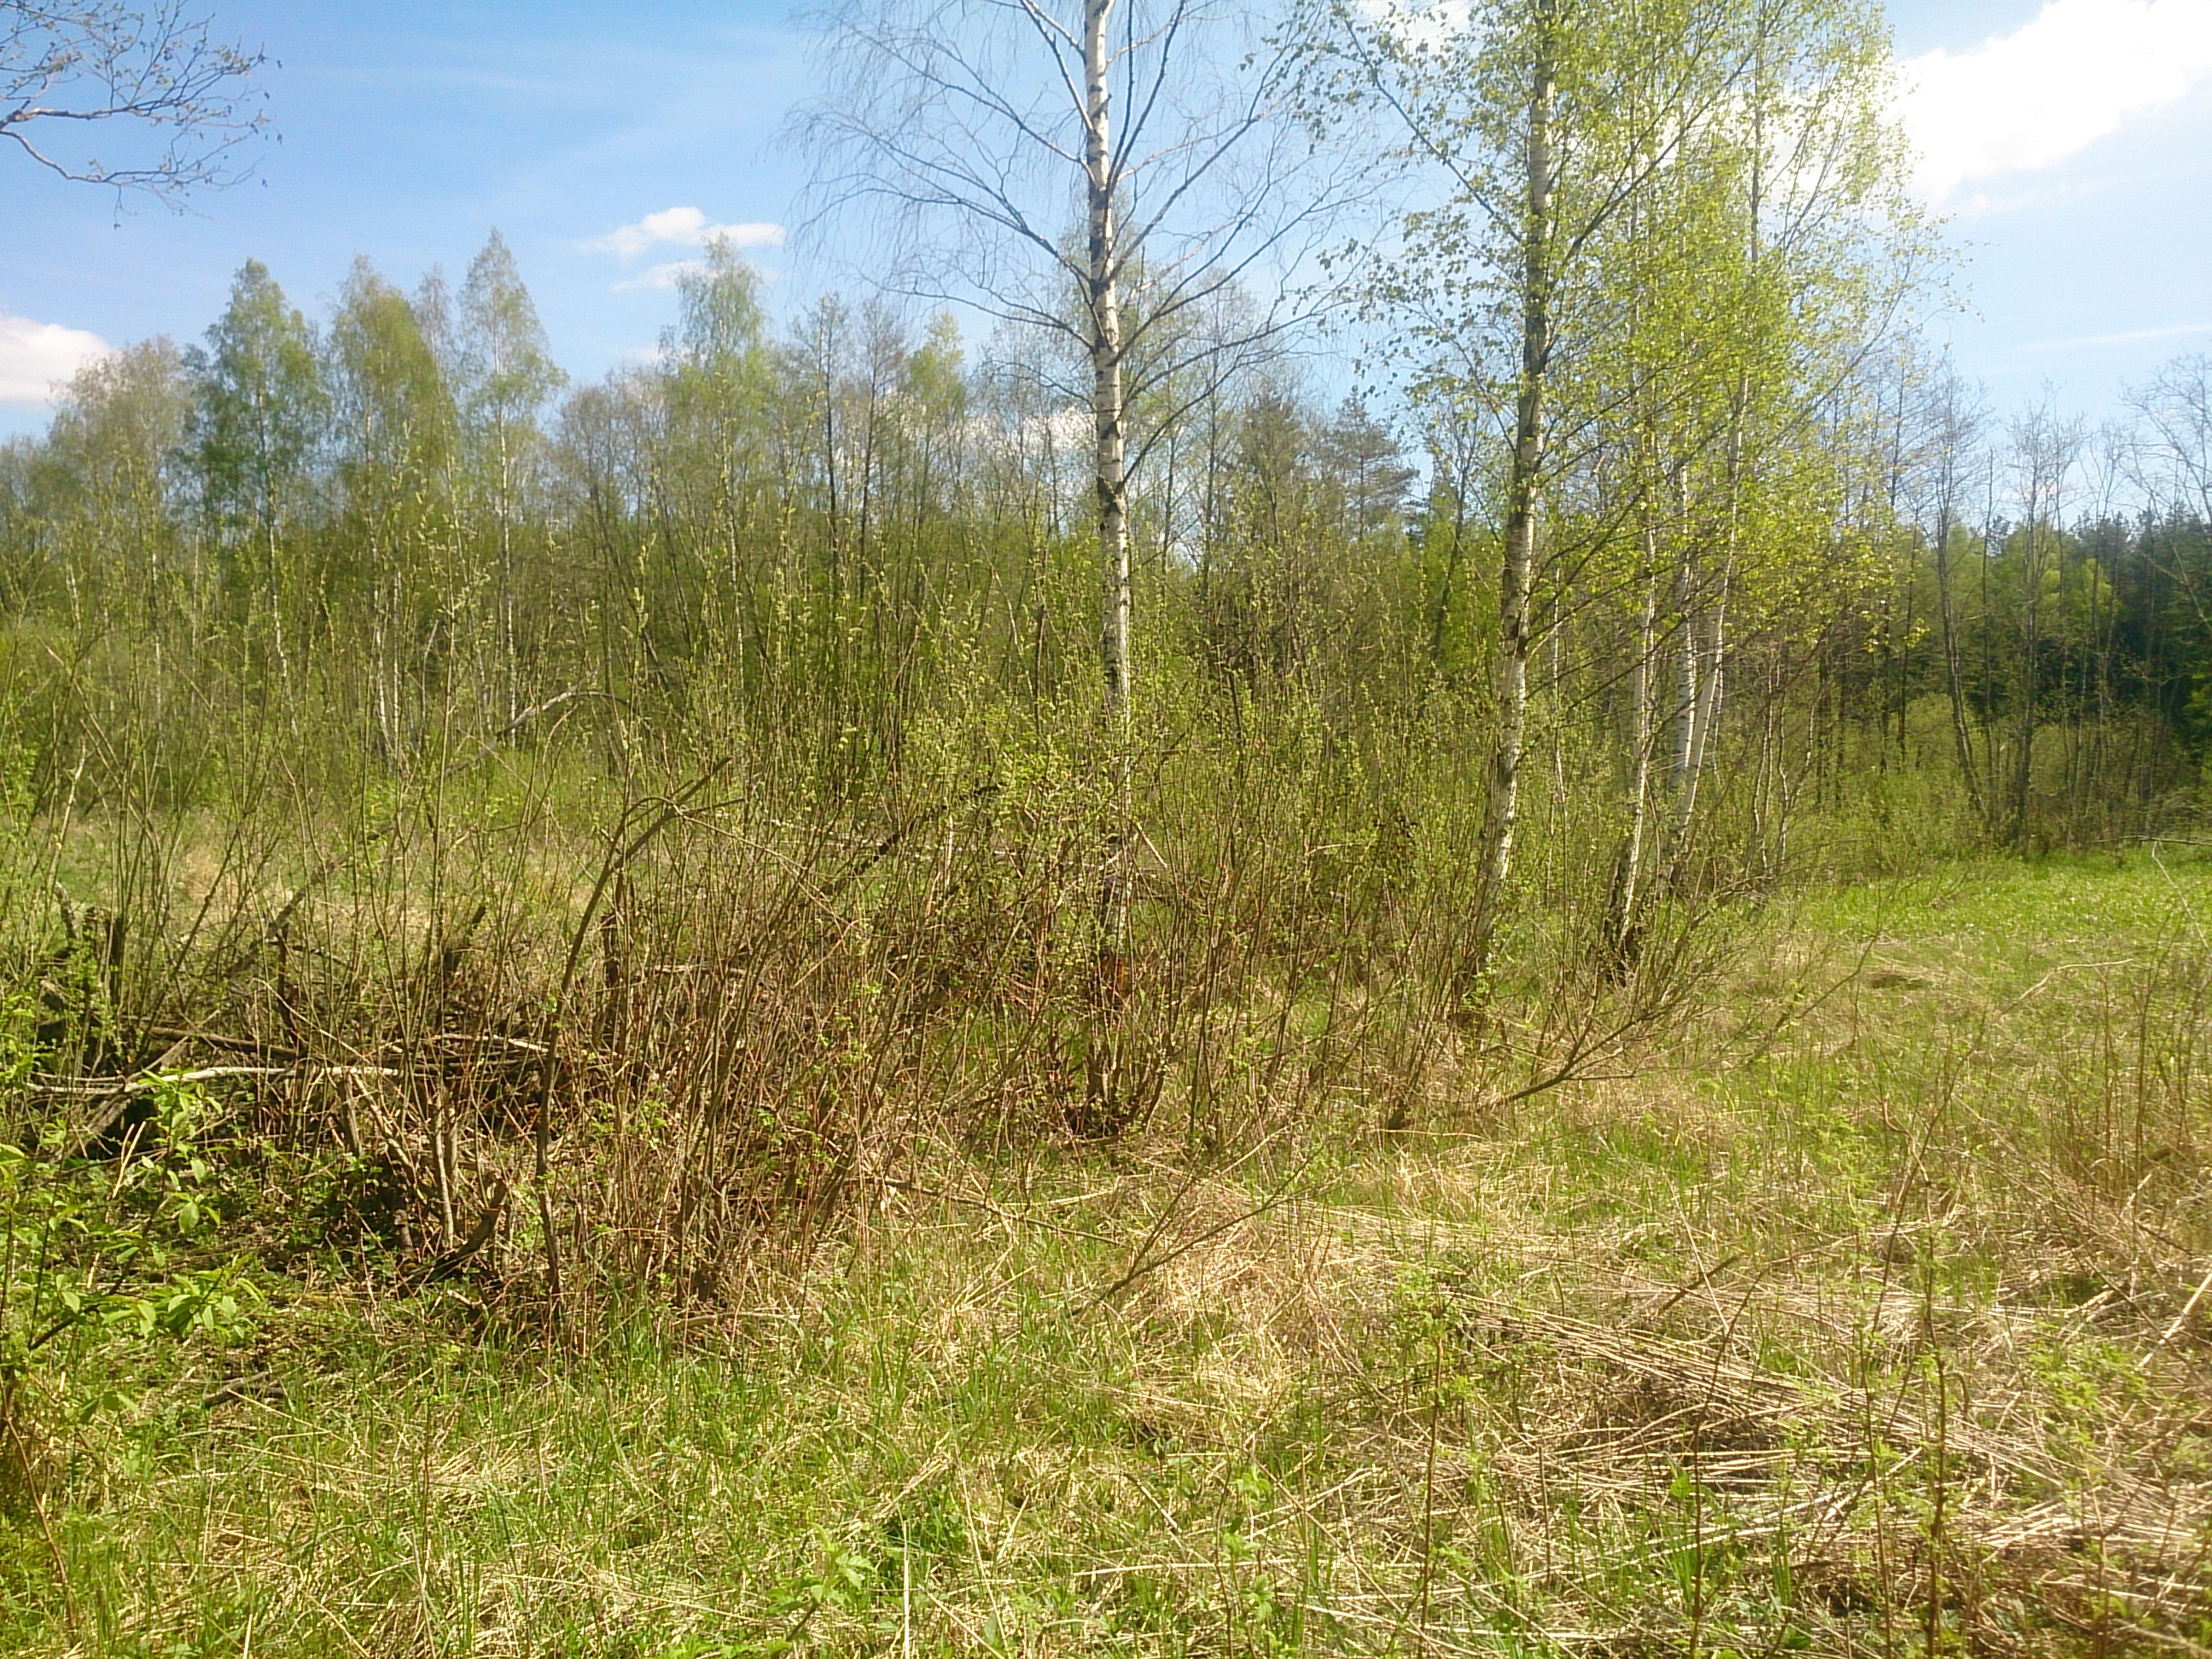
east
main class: Shrubland
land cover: Shrubland without tree cover
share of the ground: > 75 %
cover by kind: shrubs 70 %, herbaceous plants 30 %
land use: Semi-natural and natural areas not in use
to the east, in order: Shrubland without tree cover; Ditches and canals; Broadleaved woodland; Grassland without tree/shrub cover; Broadleaved woodland; Ditches and canals; Broadleaved woodland; Grassland without tree/shrub cover; Broadleaved woodland; Spontaneously vegetated surfaces; Other mixed woodland
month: May
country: LV
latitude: 56.6722
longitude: 24.3718
